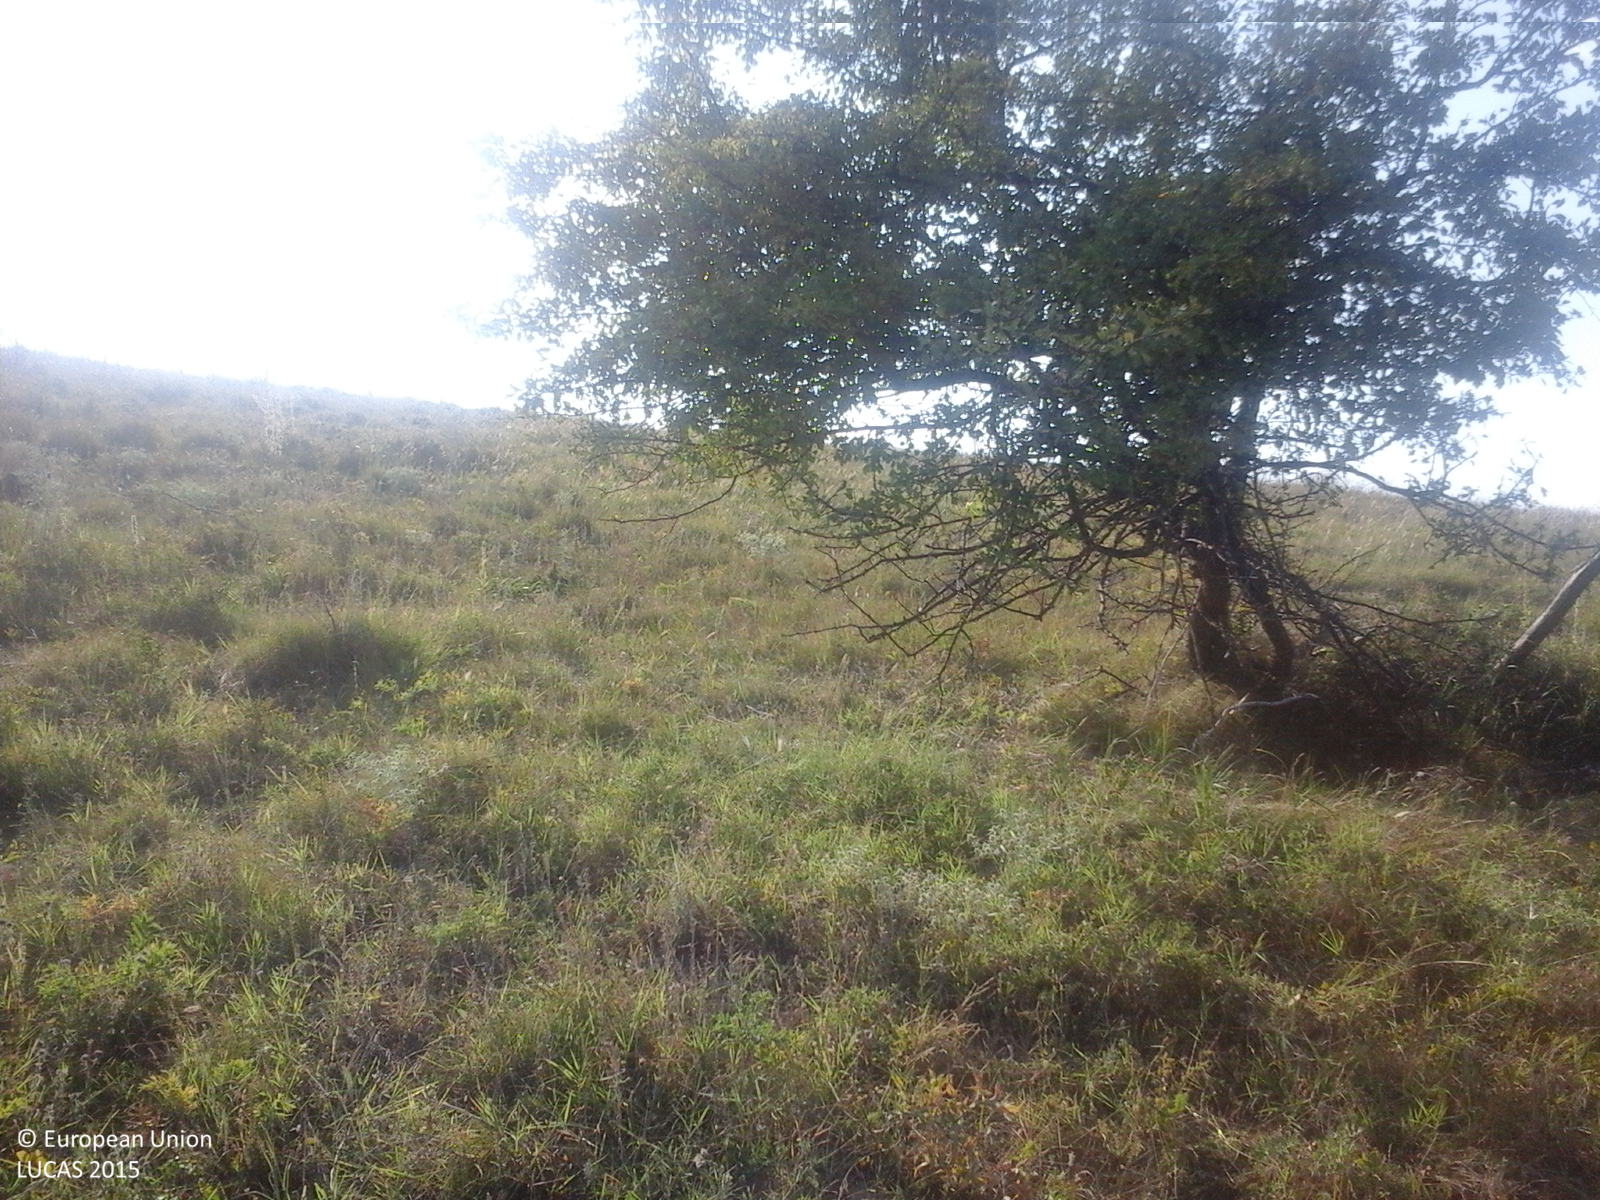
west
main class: Grassland
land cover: Grassland with sparse tree/shrub cover
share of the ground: > 75 %
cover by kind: herbaceous plants 85 %, shrubs 10 %, broadleaved forest trees 5 %
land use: Fallow land
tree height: > 5 m
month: July
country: RO
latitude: 46.5923
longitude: 28.0227
